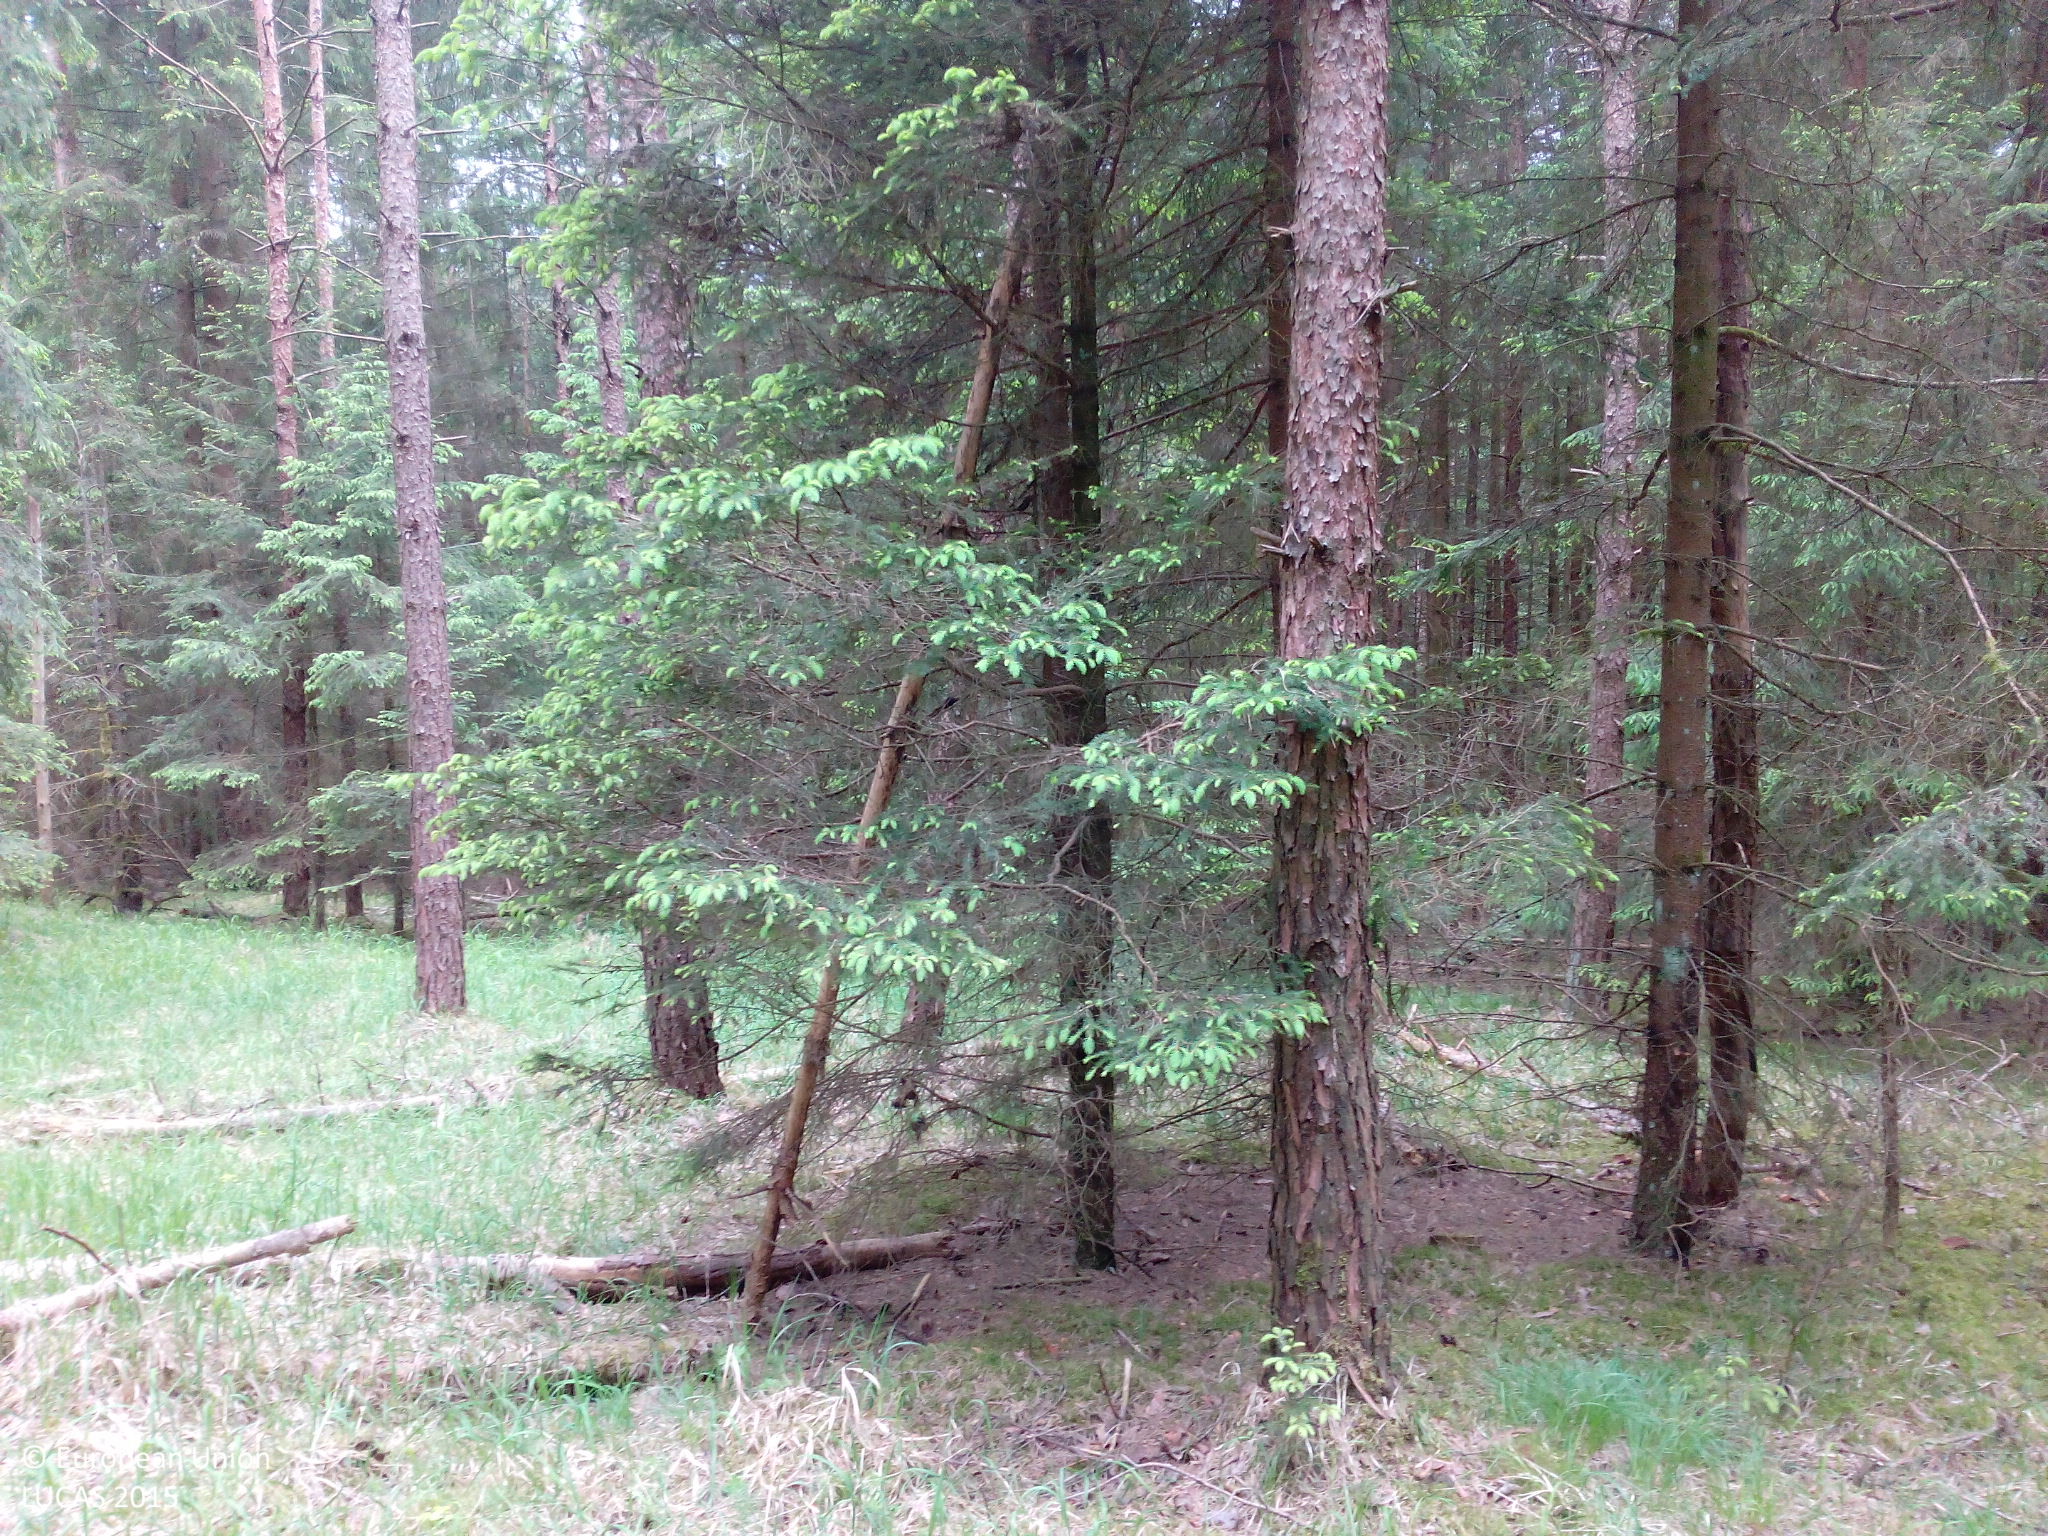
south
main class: Woodland
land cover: Other coniferous woodland
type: hemiboreal forest and nemoral coniferous forest and mixed broadleaved-coniferous forest
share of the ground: 50 - 75 %
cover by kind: coniferous forest trees 60 %, herbaceous plants 40 %
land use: Forestry
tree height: > 5 m
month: May
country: DE
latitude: 49.7609
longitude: 11.4850
